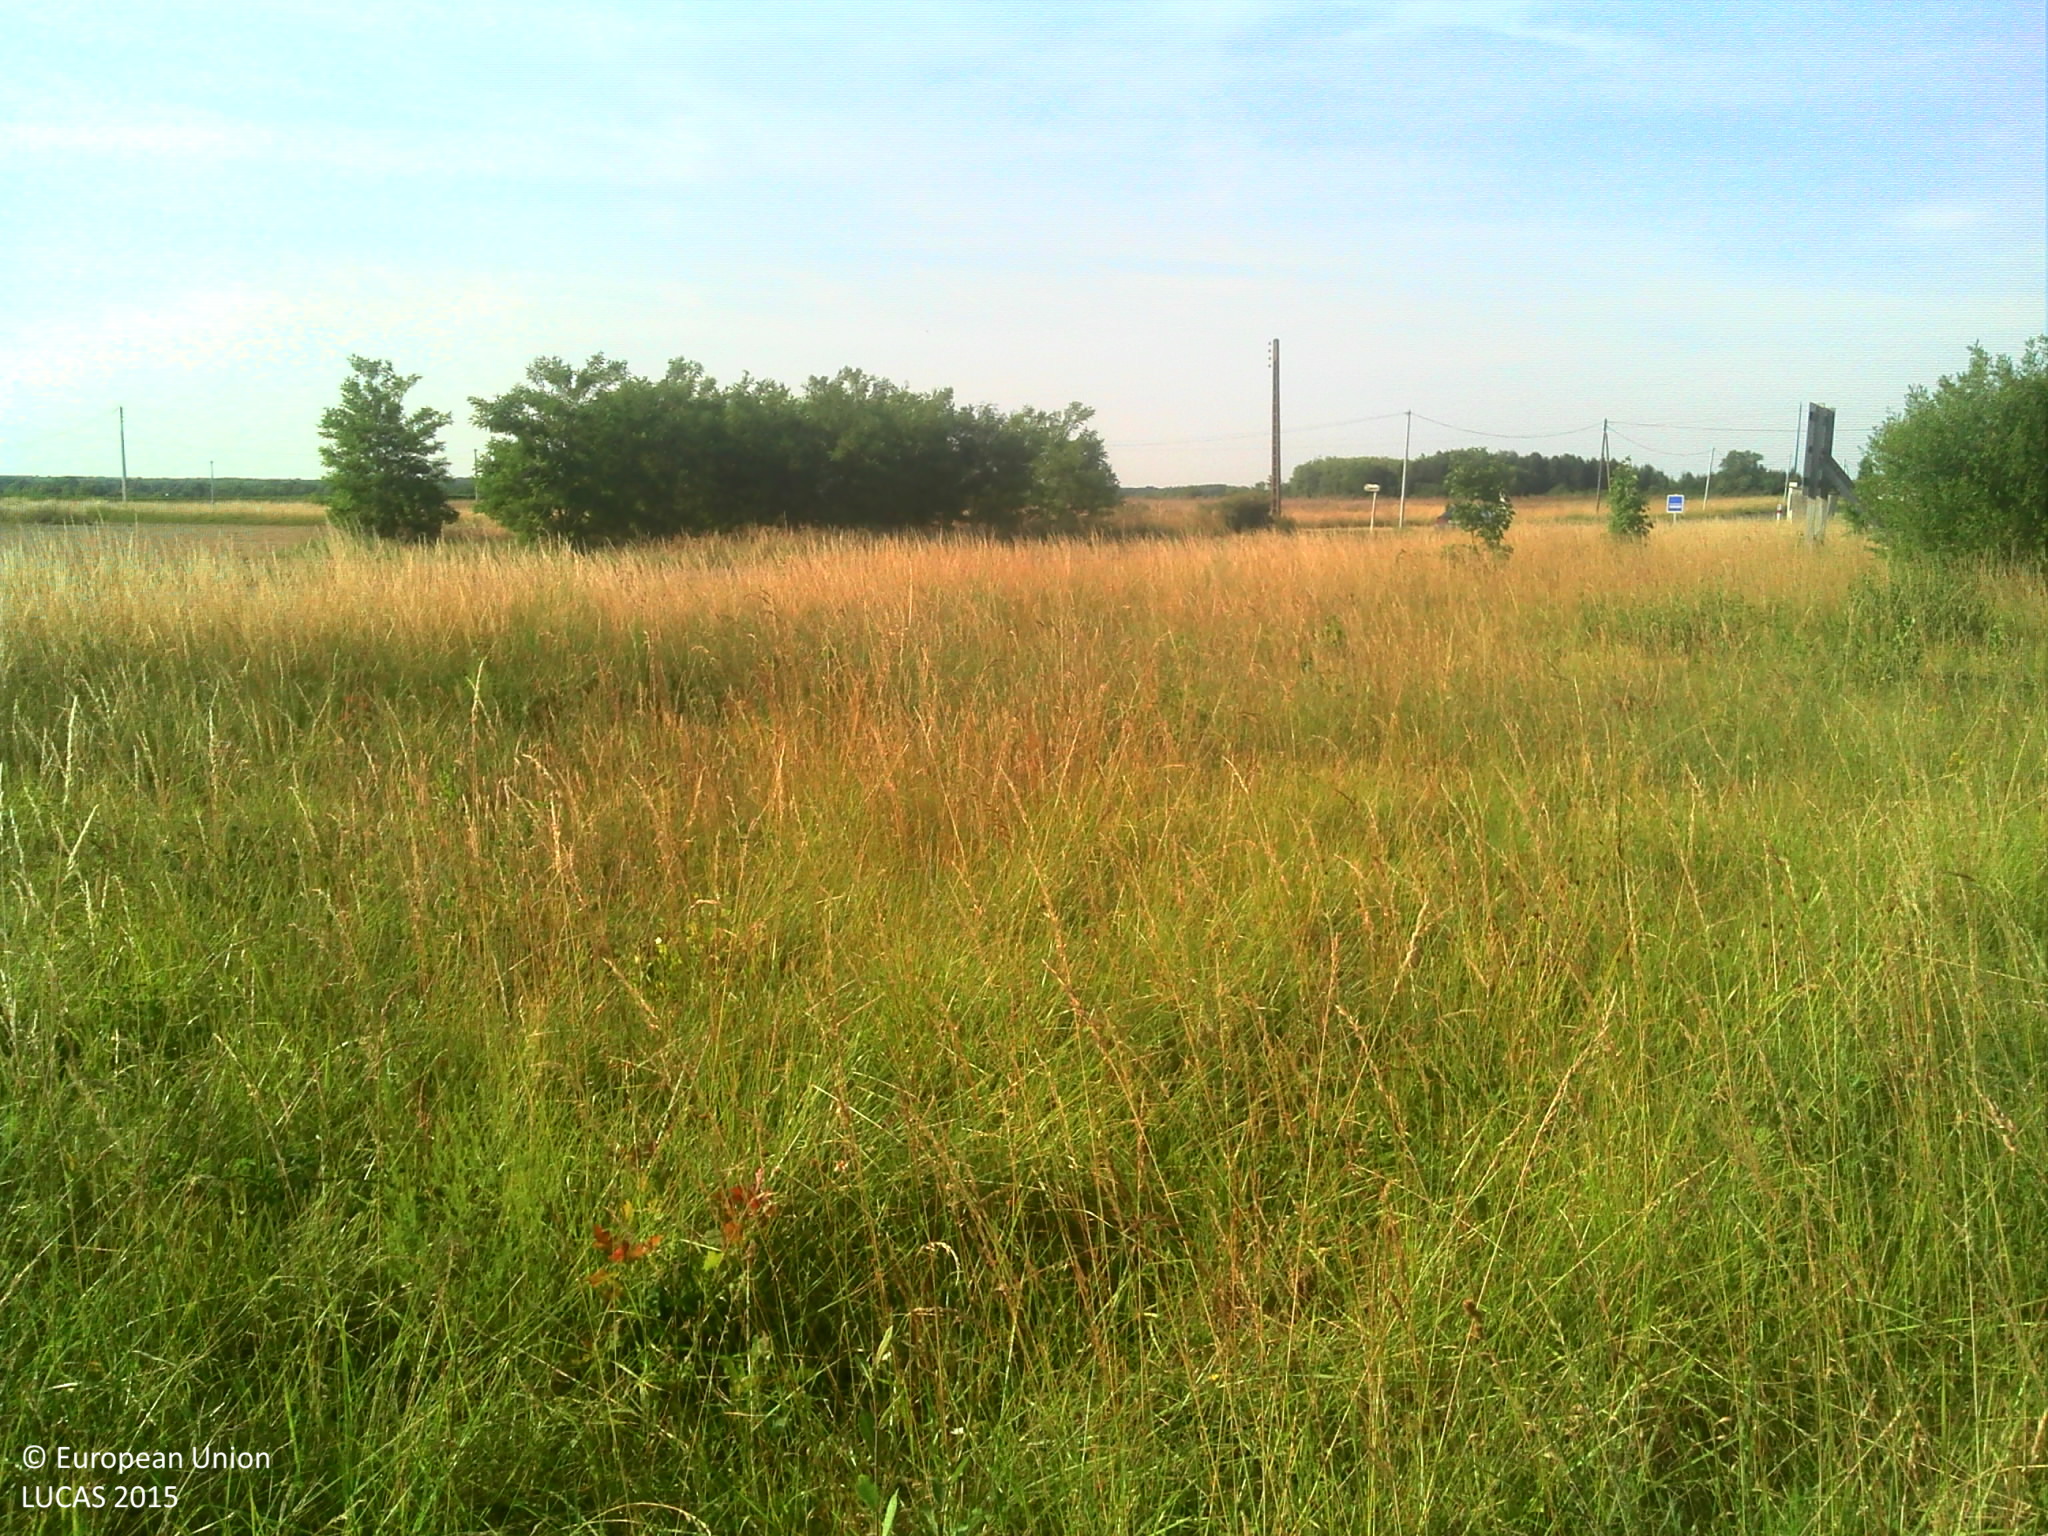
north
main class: Grassland
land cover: Grassland with sparse tree/shrub cover
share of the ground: > 75 %
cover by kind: herbaceous plants 95 %, broadleaved forest trees 5 %
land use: Construction
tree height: > 5 m
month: June
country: FR
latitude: 47.3994
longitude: 1.4132
